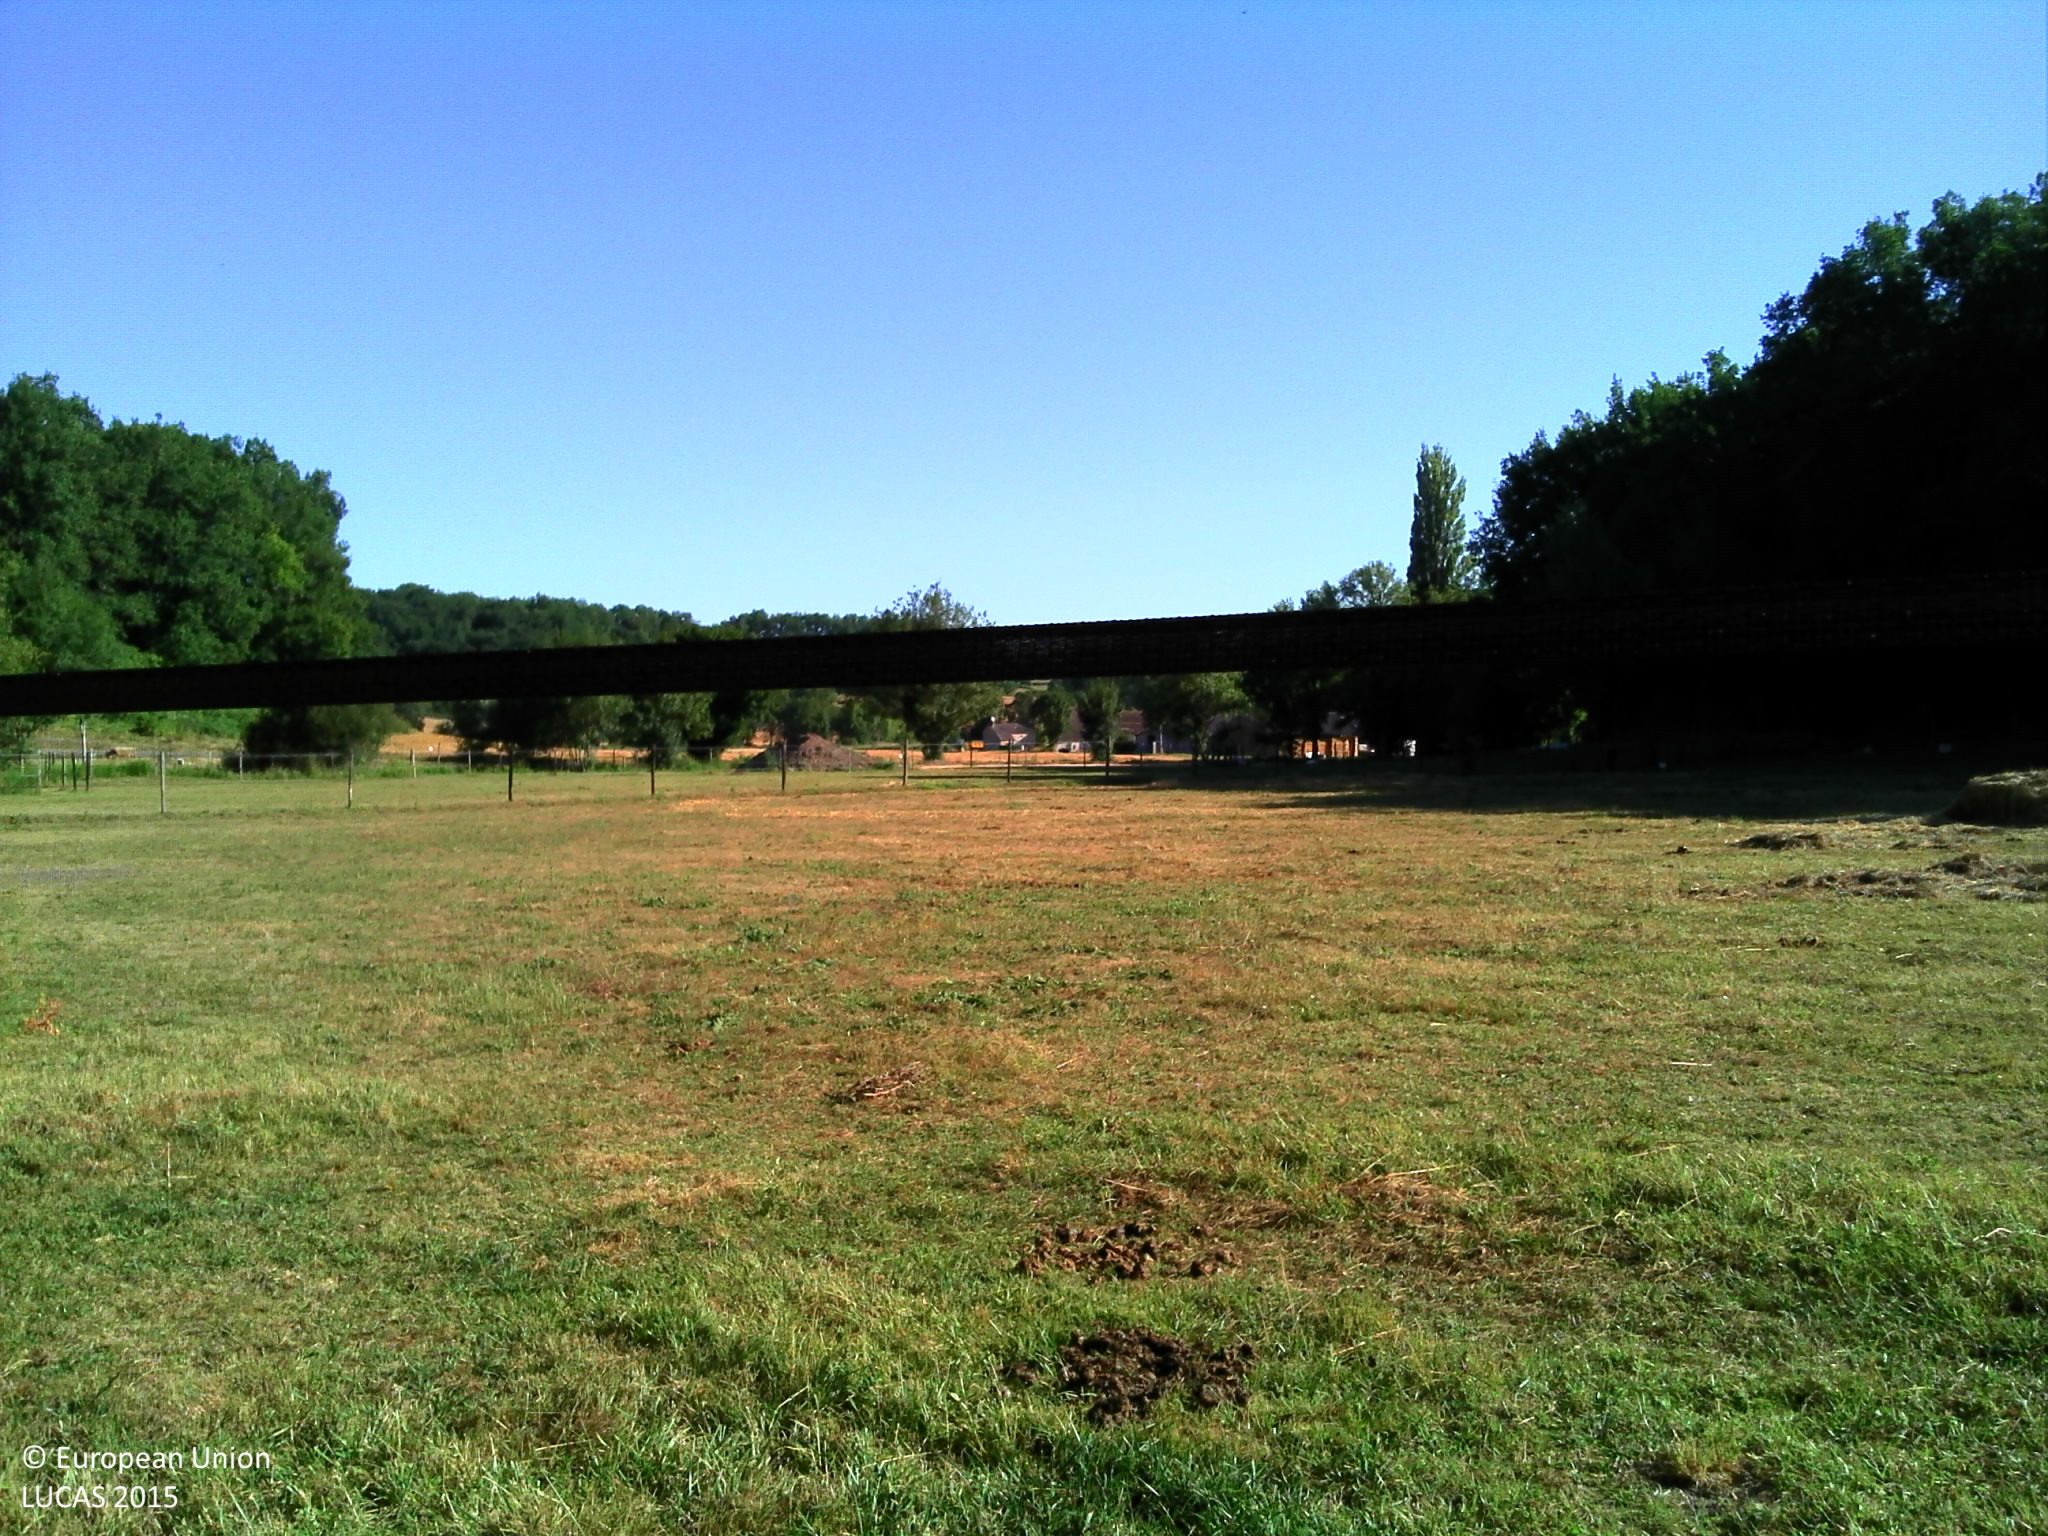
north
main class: Grassland
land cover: Grassland without tree/shrub cover
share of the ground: > 75 %
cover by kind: herbaceous plants 90 %, lichens and mosses 10 %
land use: Agriculture (excluding fallow land and kitchen gardens)
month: July
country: FR
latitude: 44.7559
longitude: 0.5803
